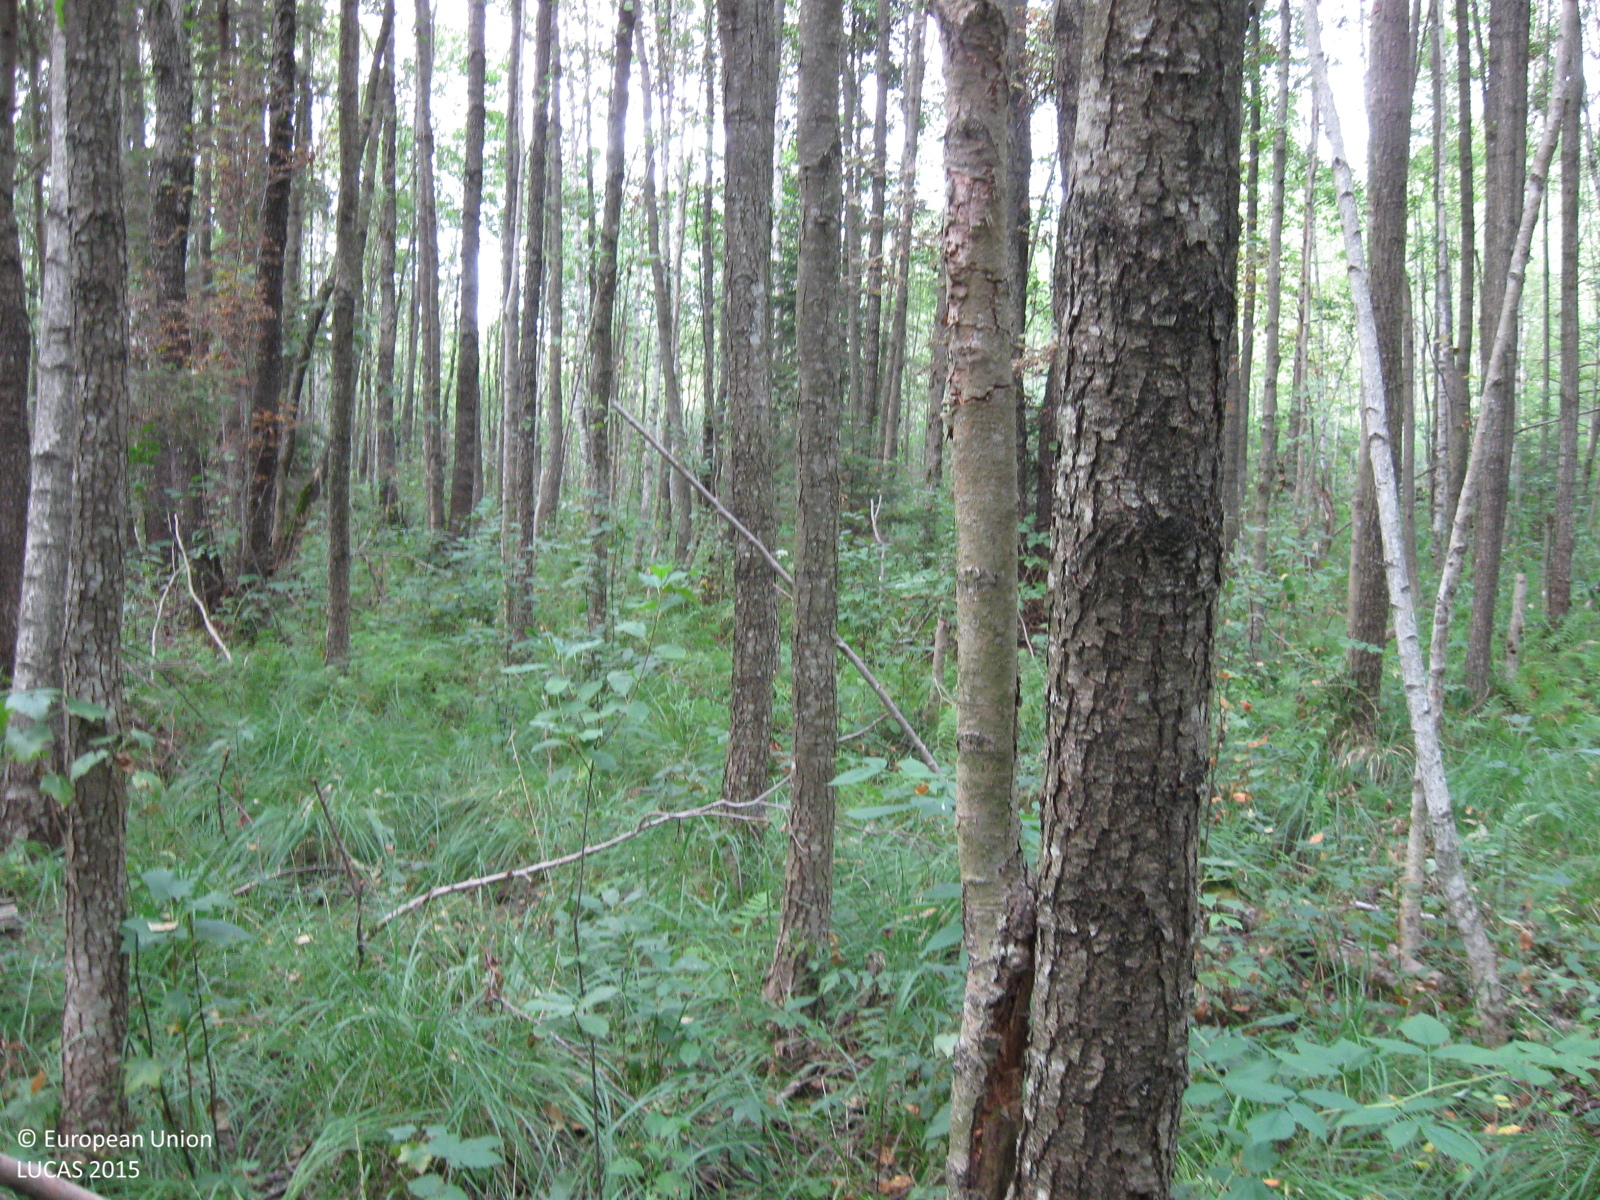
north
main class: Woodland
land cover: Broadleaved woodland
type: non-riverine alder, birch or aspen forest
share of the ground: > 75 %
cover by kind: broadleaved forest trees 85 %, herbaceous plants 10 %, coniferous forest trees 5 %
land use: Forestry
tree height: > 5 m
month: August
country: LT
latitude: 55.5770
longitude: 23.3522
